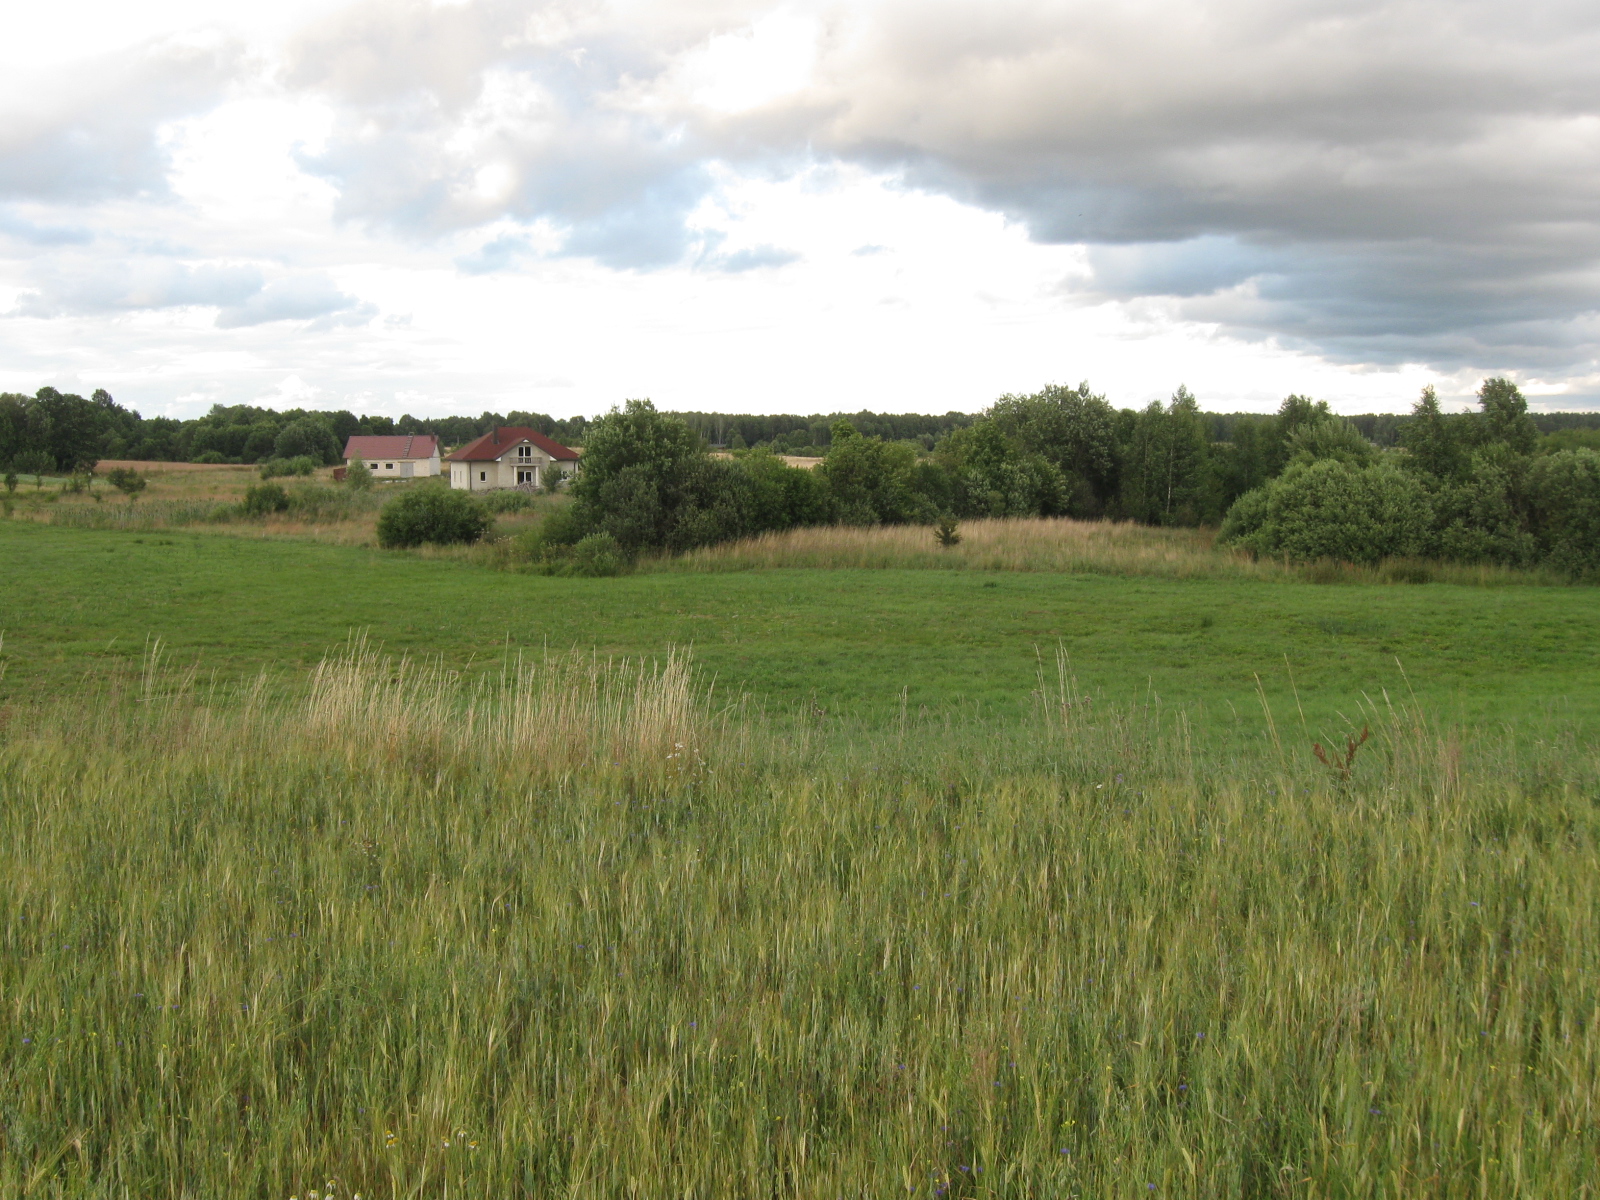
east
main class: Cropland
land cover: Barley
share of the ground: > 75 %
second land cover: Oats
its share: 10 - 25 %
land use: Agriculture (excluding fallow land and kitchen gardens)
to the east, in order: Barley; Oats; Grassland without tree/shrub cover; Broadleaved woodland; Ditches and canals; Broadleaved woodland; Spontaneously vegetated surfaces; Apple fruit; Spontaneously vegetated surfaces; Abandoned hedges; Grassland without tree/shrub cover; Tracks; Grassland with sparse tree/shrub cover
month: July
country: LT
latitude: 54.3496
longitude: 24.3621
